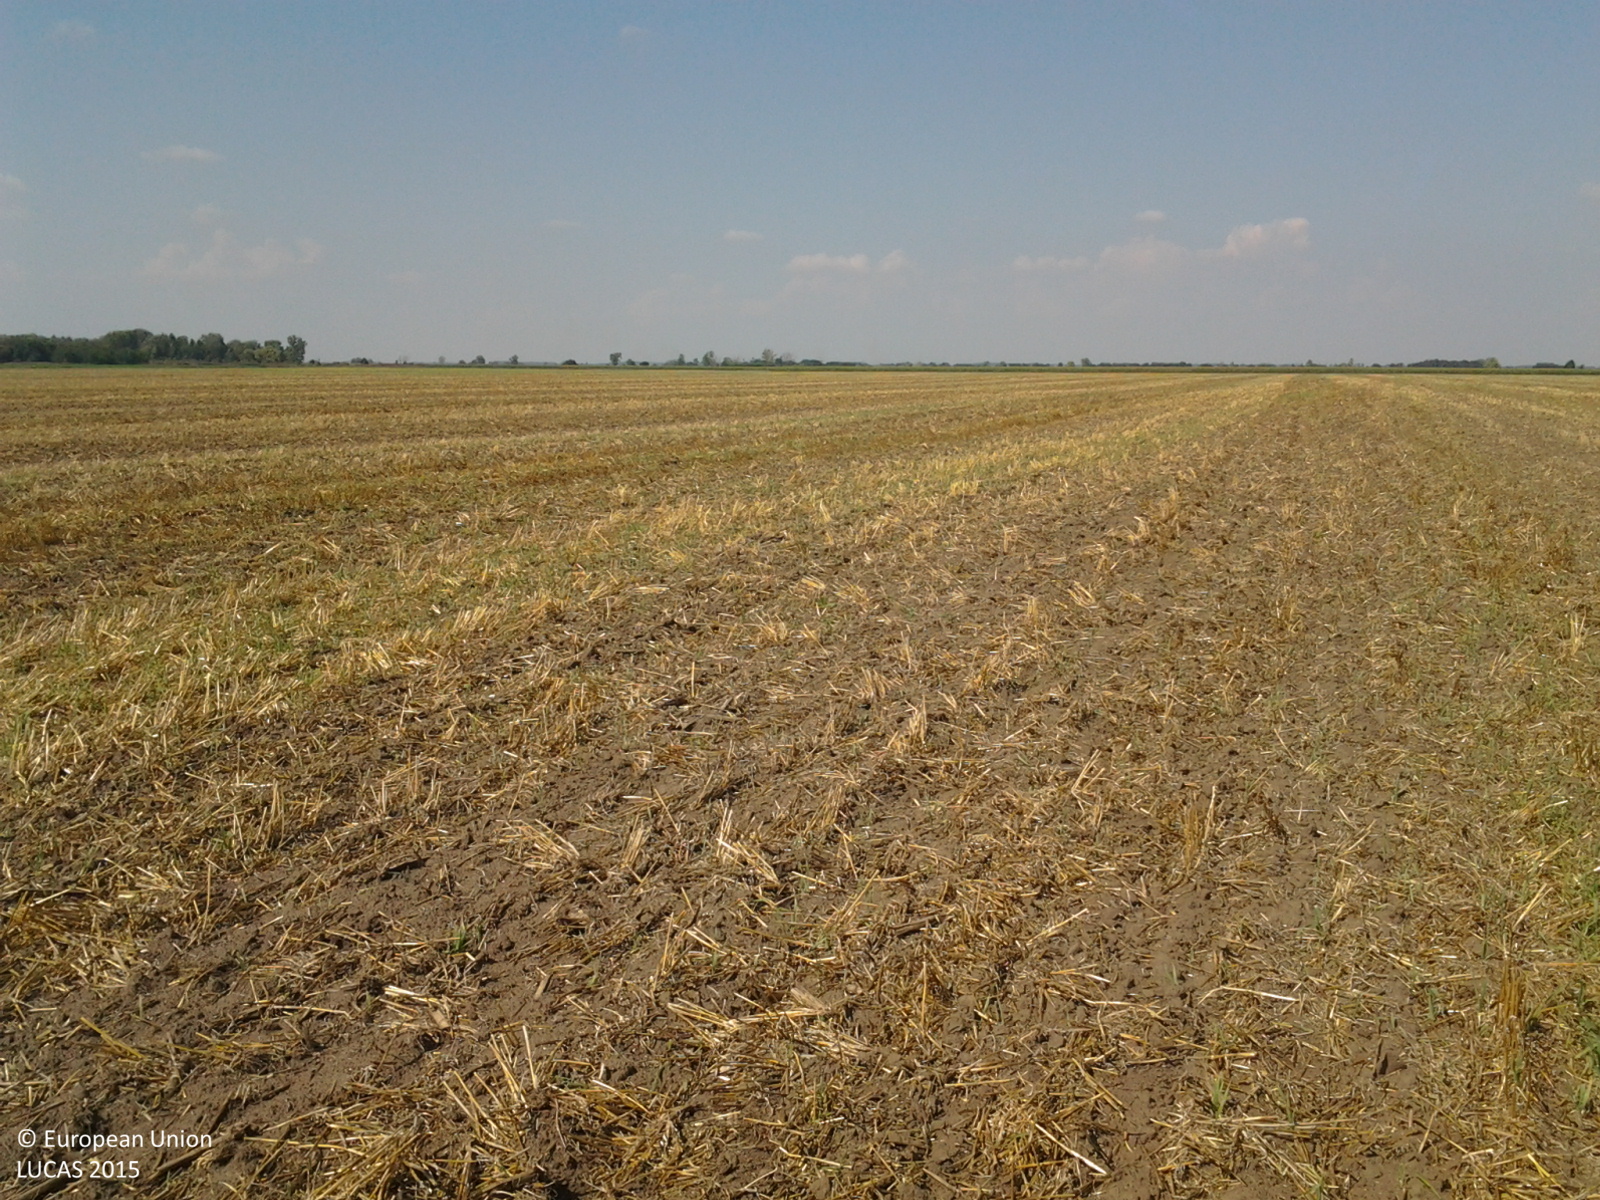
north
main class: Cropland
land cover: Barley
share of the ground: 10 - 25 %
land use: Agriculture (excluding fallow land and kitchen gardens)
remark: Harvested field
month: August
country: HU
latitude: 47.2434
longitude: 19.7860
